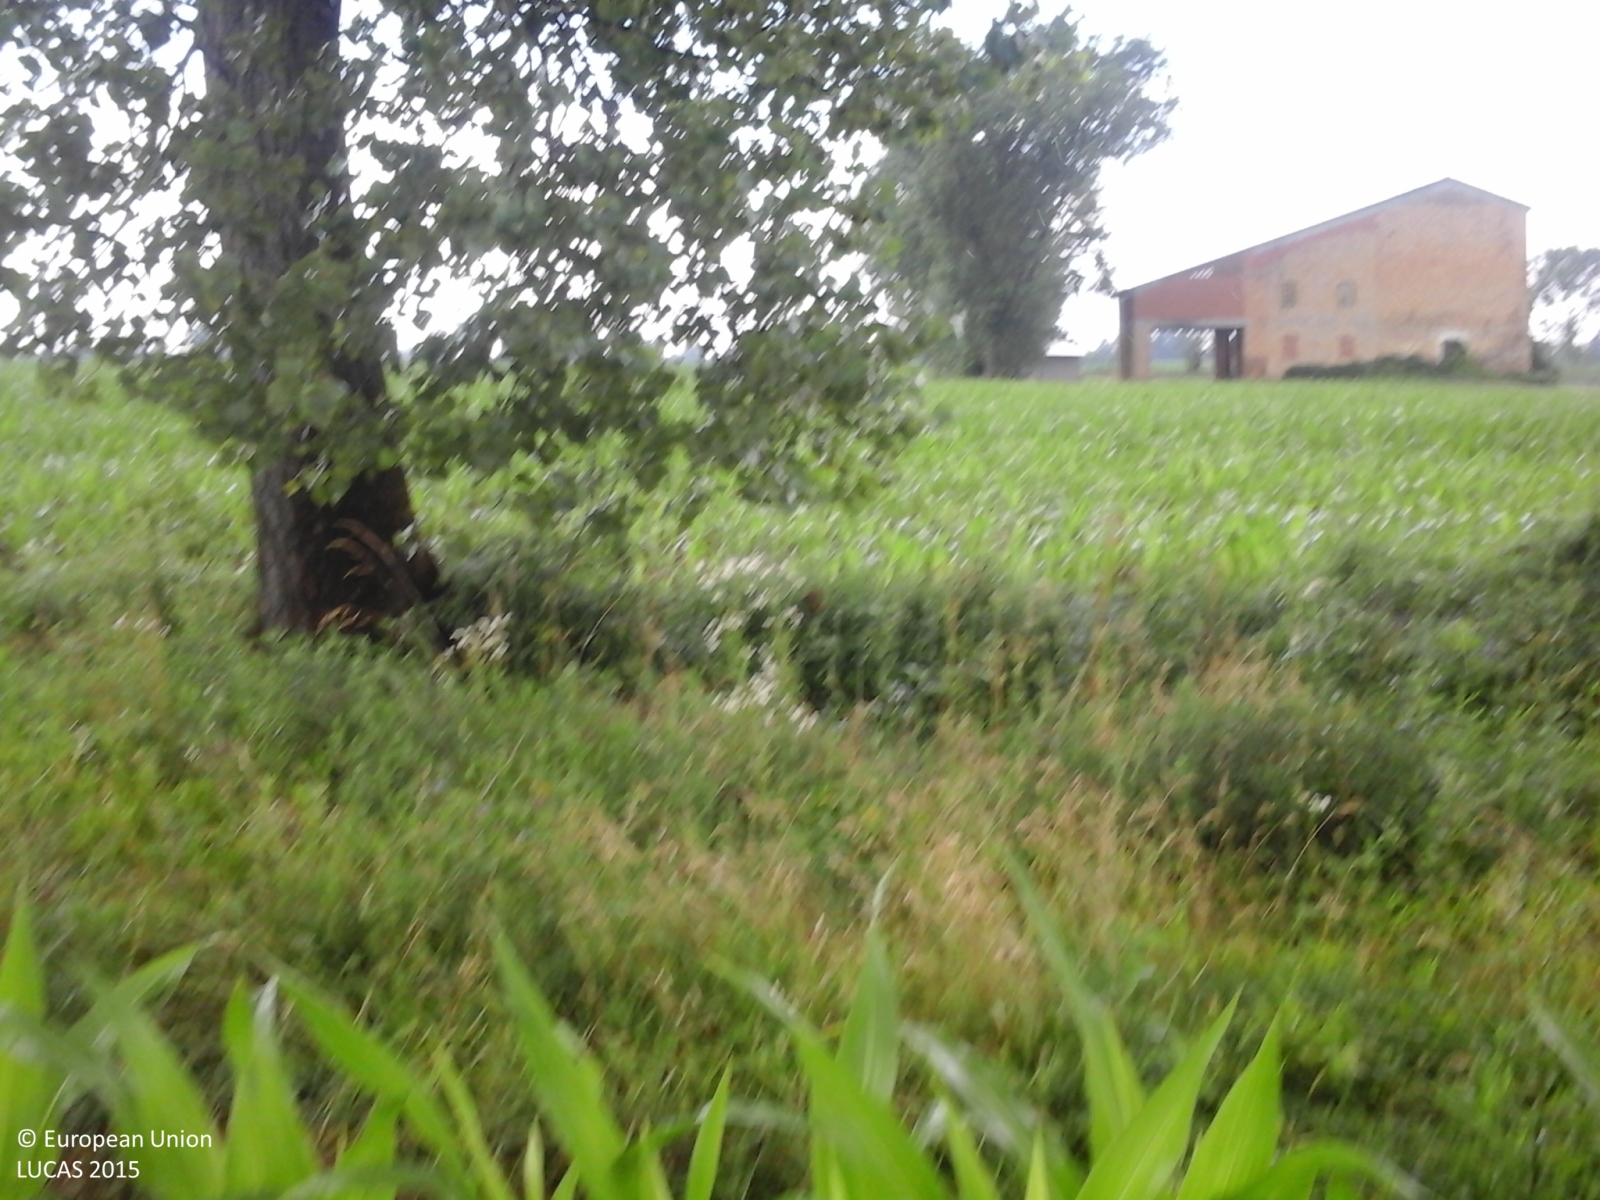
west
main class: Cropland
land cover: Maize
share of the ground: > 75 %
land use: Agriculture (excluding fallow land and kitchen gardens)
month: June
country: IT
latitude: 45.7588
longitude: 12.6834
